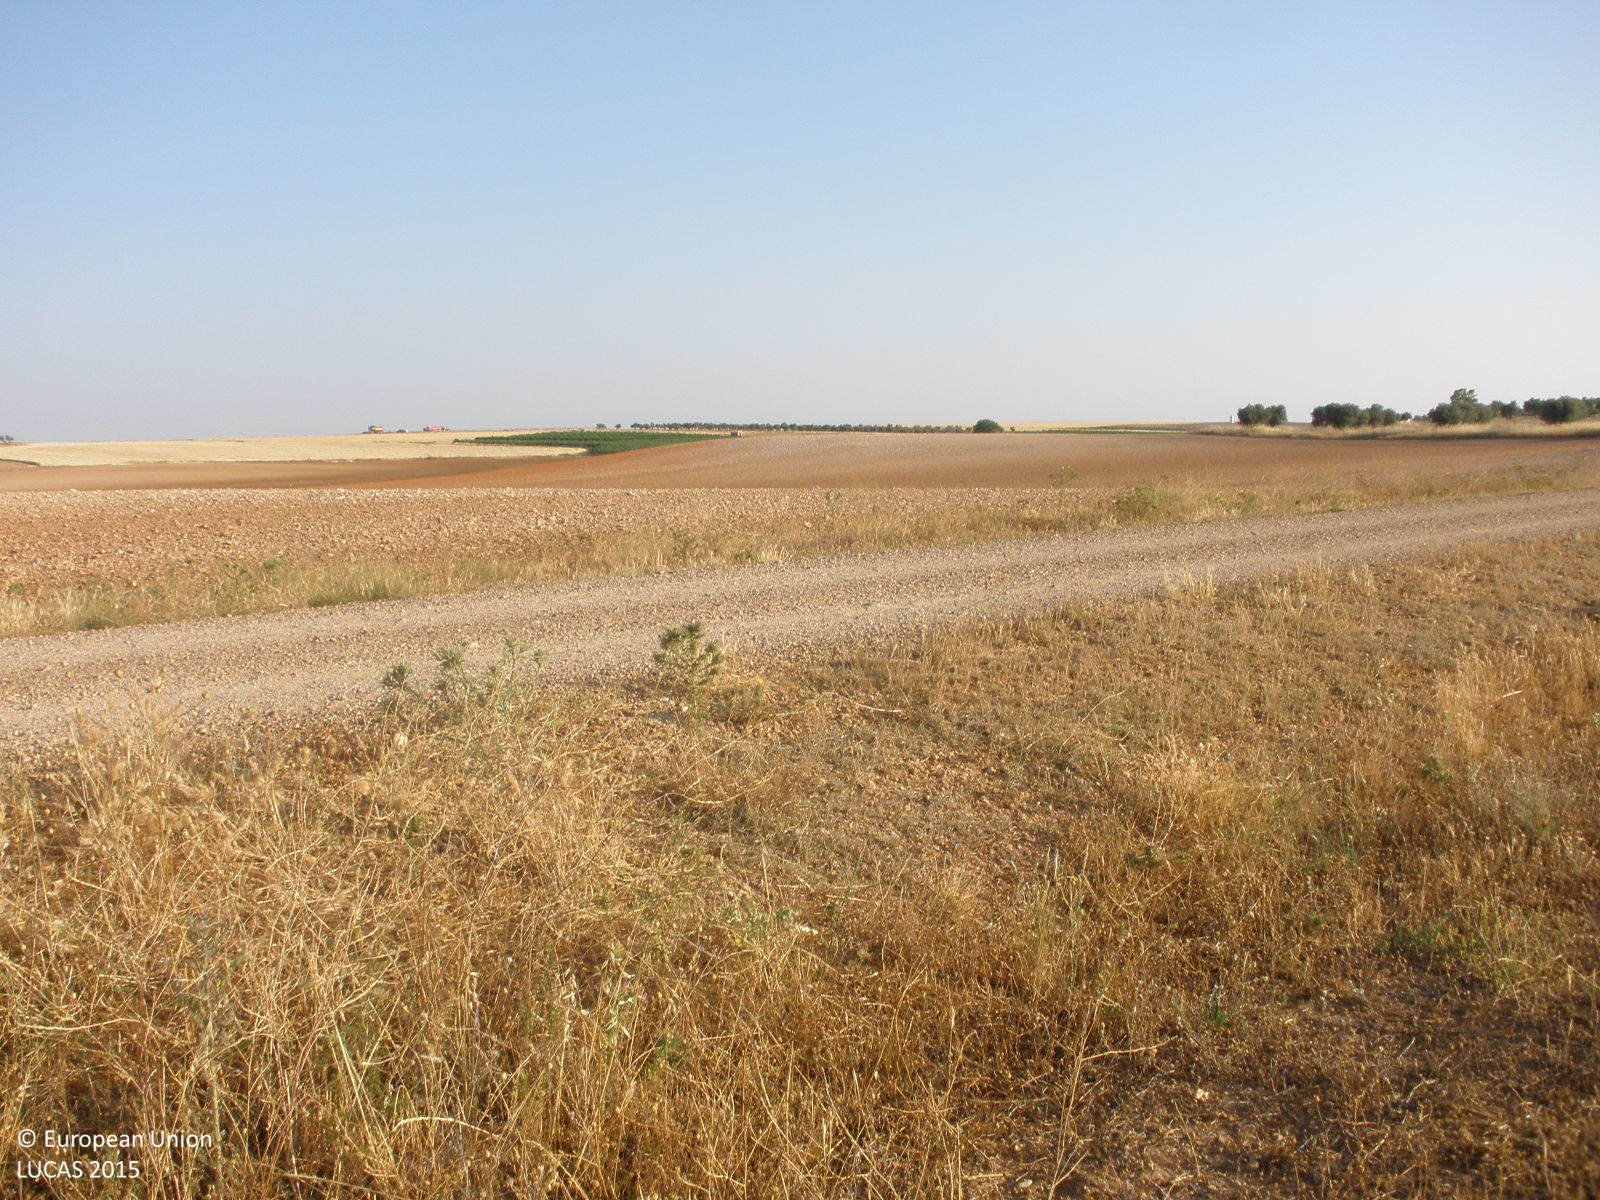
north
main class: Grassland
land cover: Spontaneously vegetated surfaces
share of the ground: > 75 %
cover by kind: herbaceous plants 85 %, unconsolidated bare surface 15 %
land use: Fallow land
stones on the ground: 25 - 50 %
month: July
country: ES
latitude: 39.9242
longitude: -3.3060
